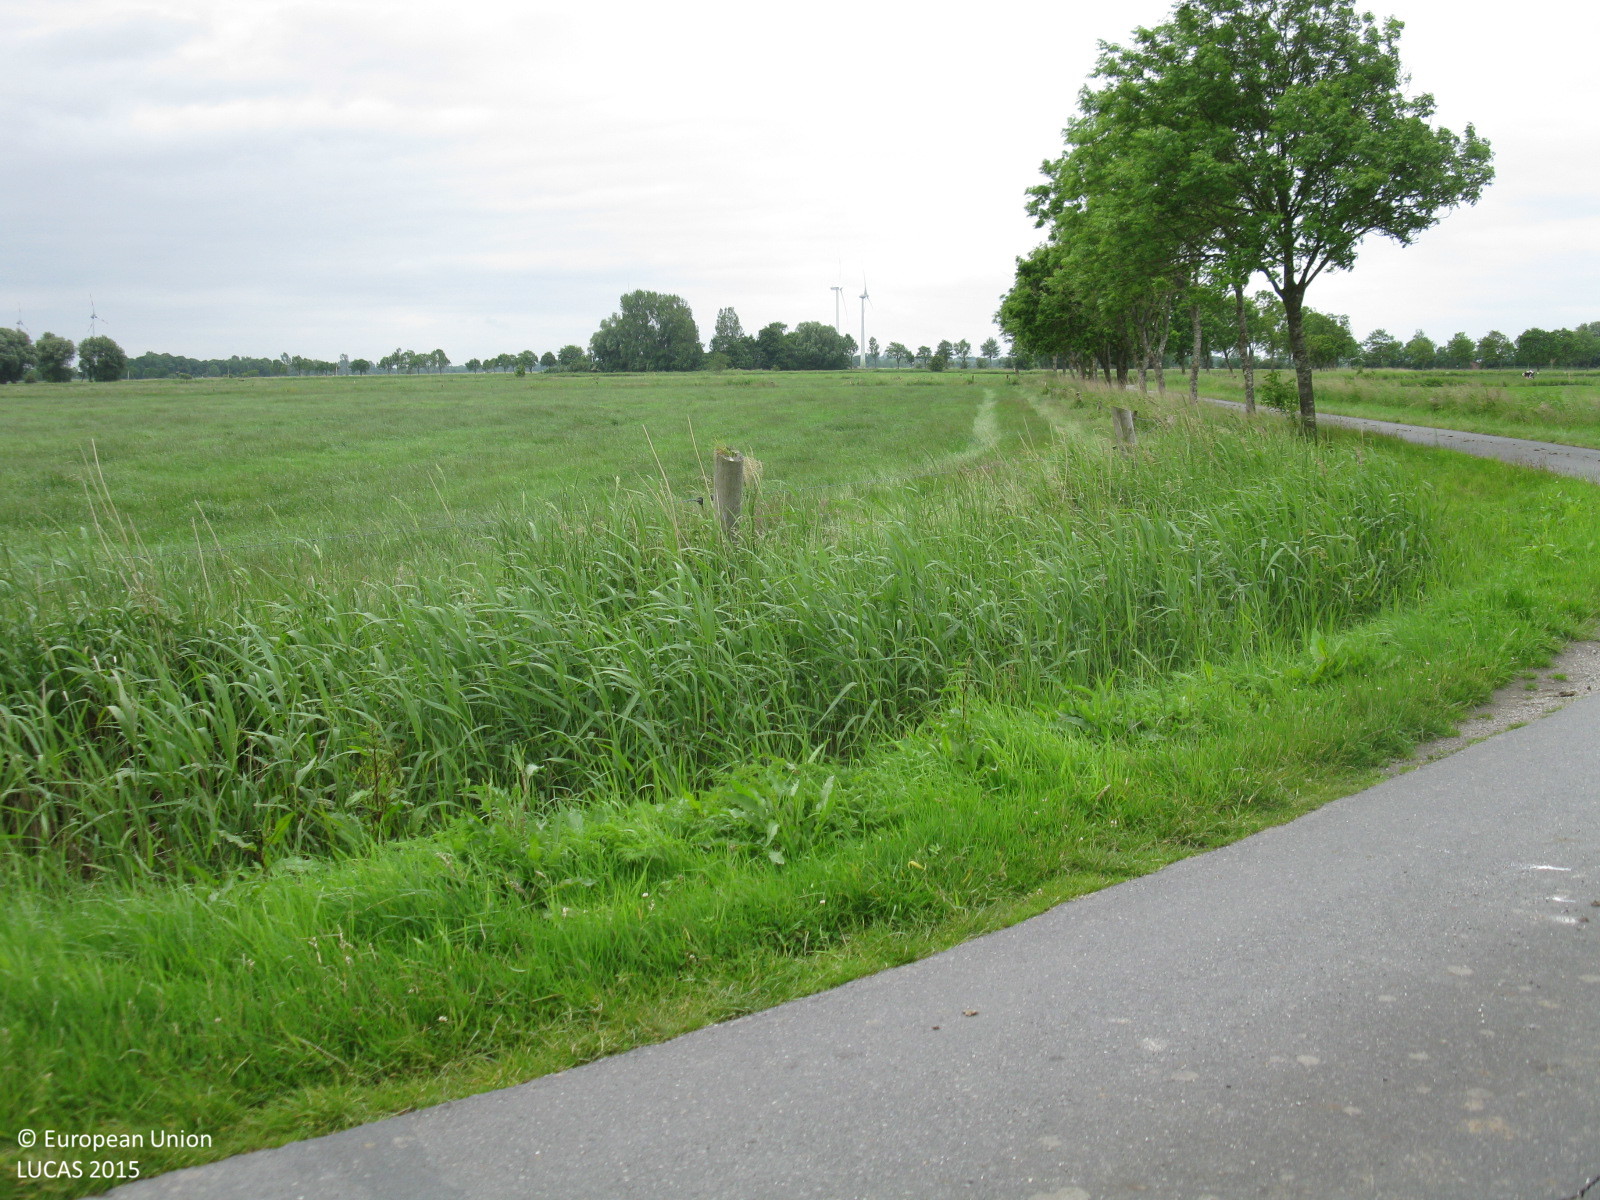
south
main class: Grassland
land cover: Grassland without tree/shrub cover
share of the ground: > 75 %
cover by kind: herbaceous plants 100 %
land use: Agriculture (excluding fallow land and kitchen gardens)
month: June
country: DE
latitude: 53.6175
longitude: 7.8995
